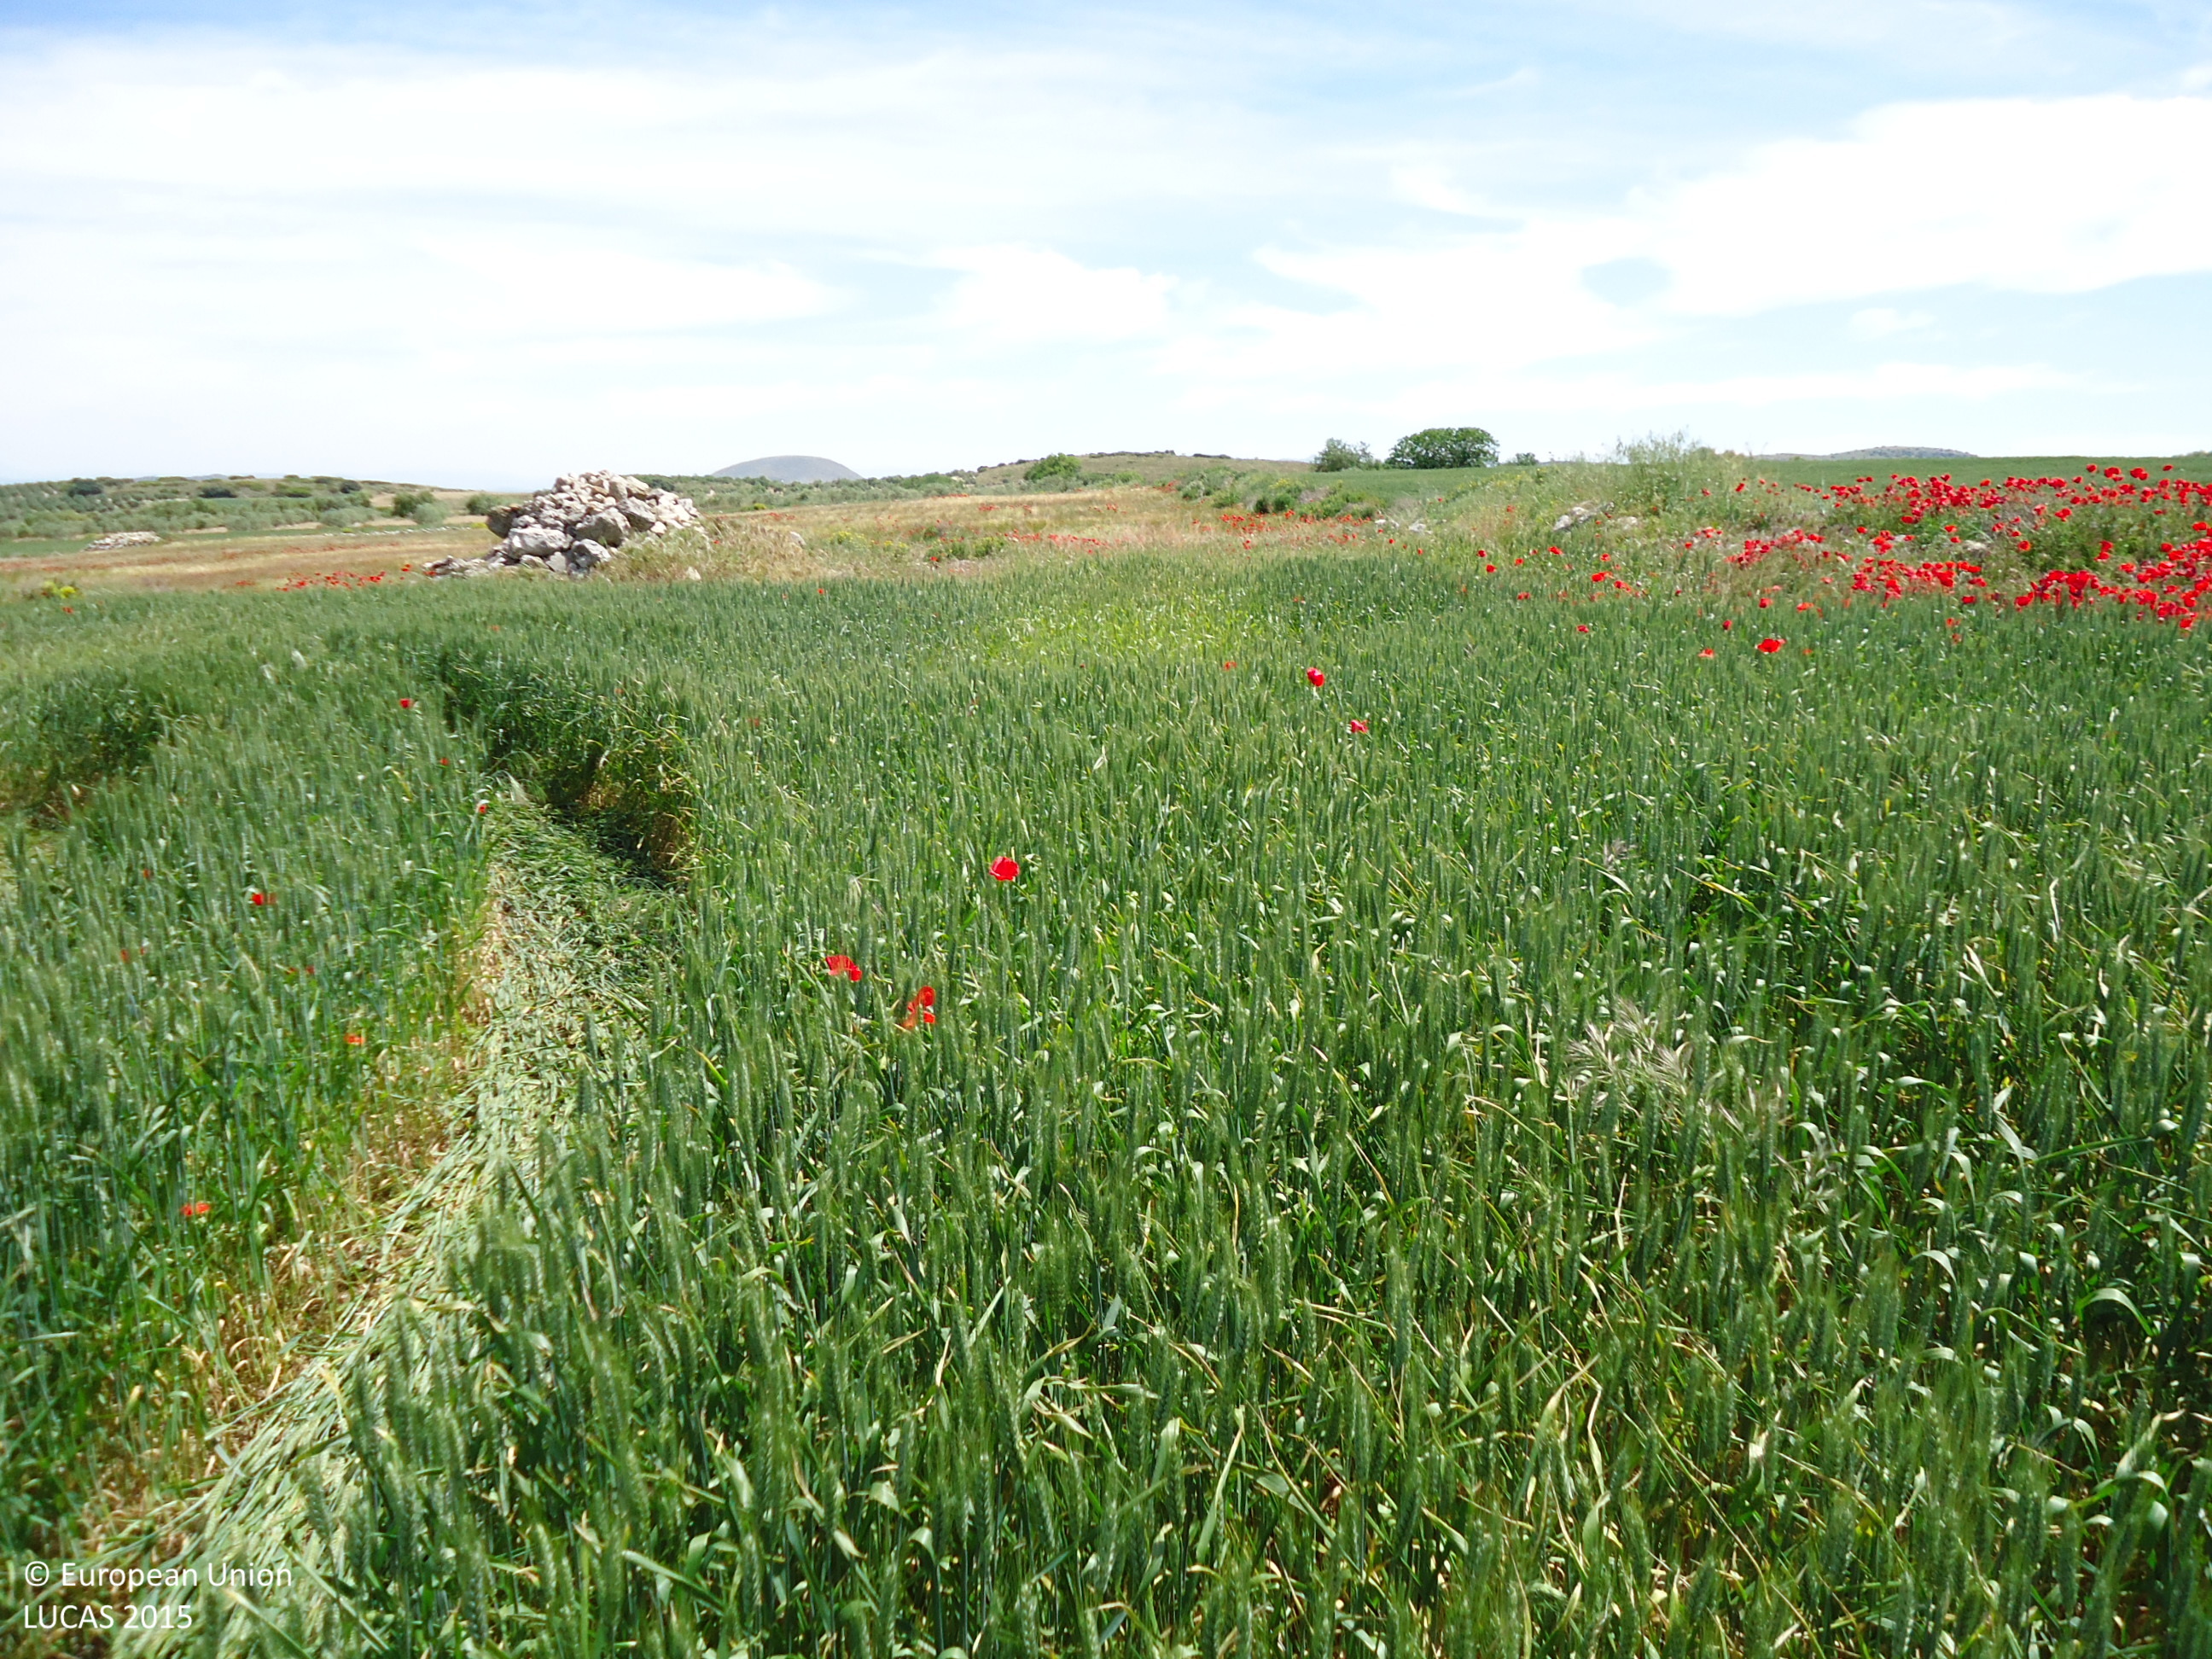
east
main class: Cropland
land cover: Common wheat
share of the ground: > 75 %
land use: Agriculture (excluding fallow land and kitchen gardens)
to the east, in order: Common wheat; Barley; Rock outcrops; Barley; Dry stone walls; Common wheat; Dry stone walls; Rivers and streams; Dry stone walls; Olive groves; Dry stone walls; Abandoned hedges
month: May
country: ES
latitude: 36.9742
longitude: -4.9977
